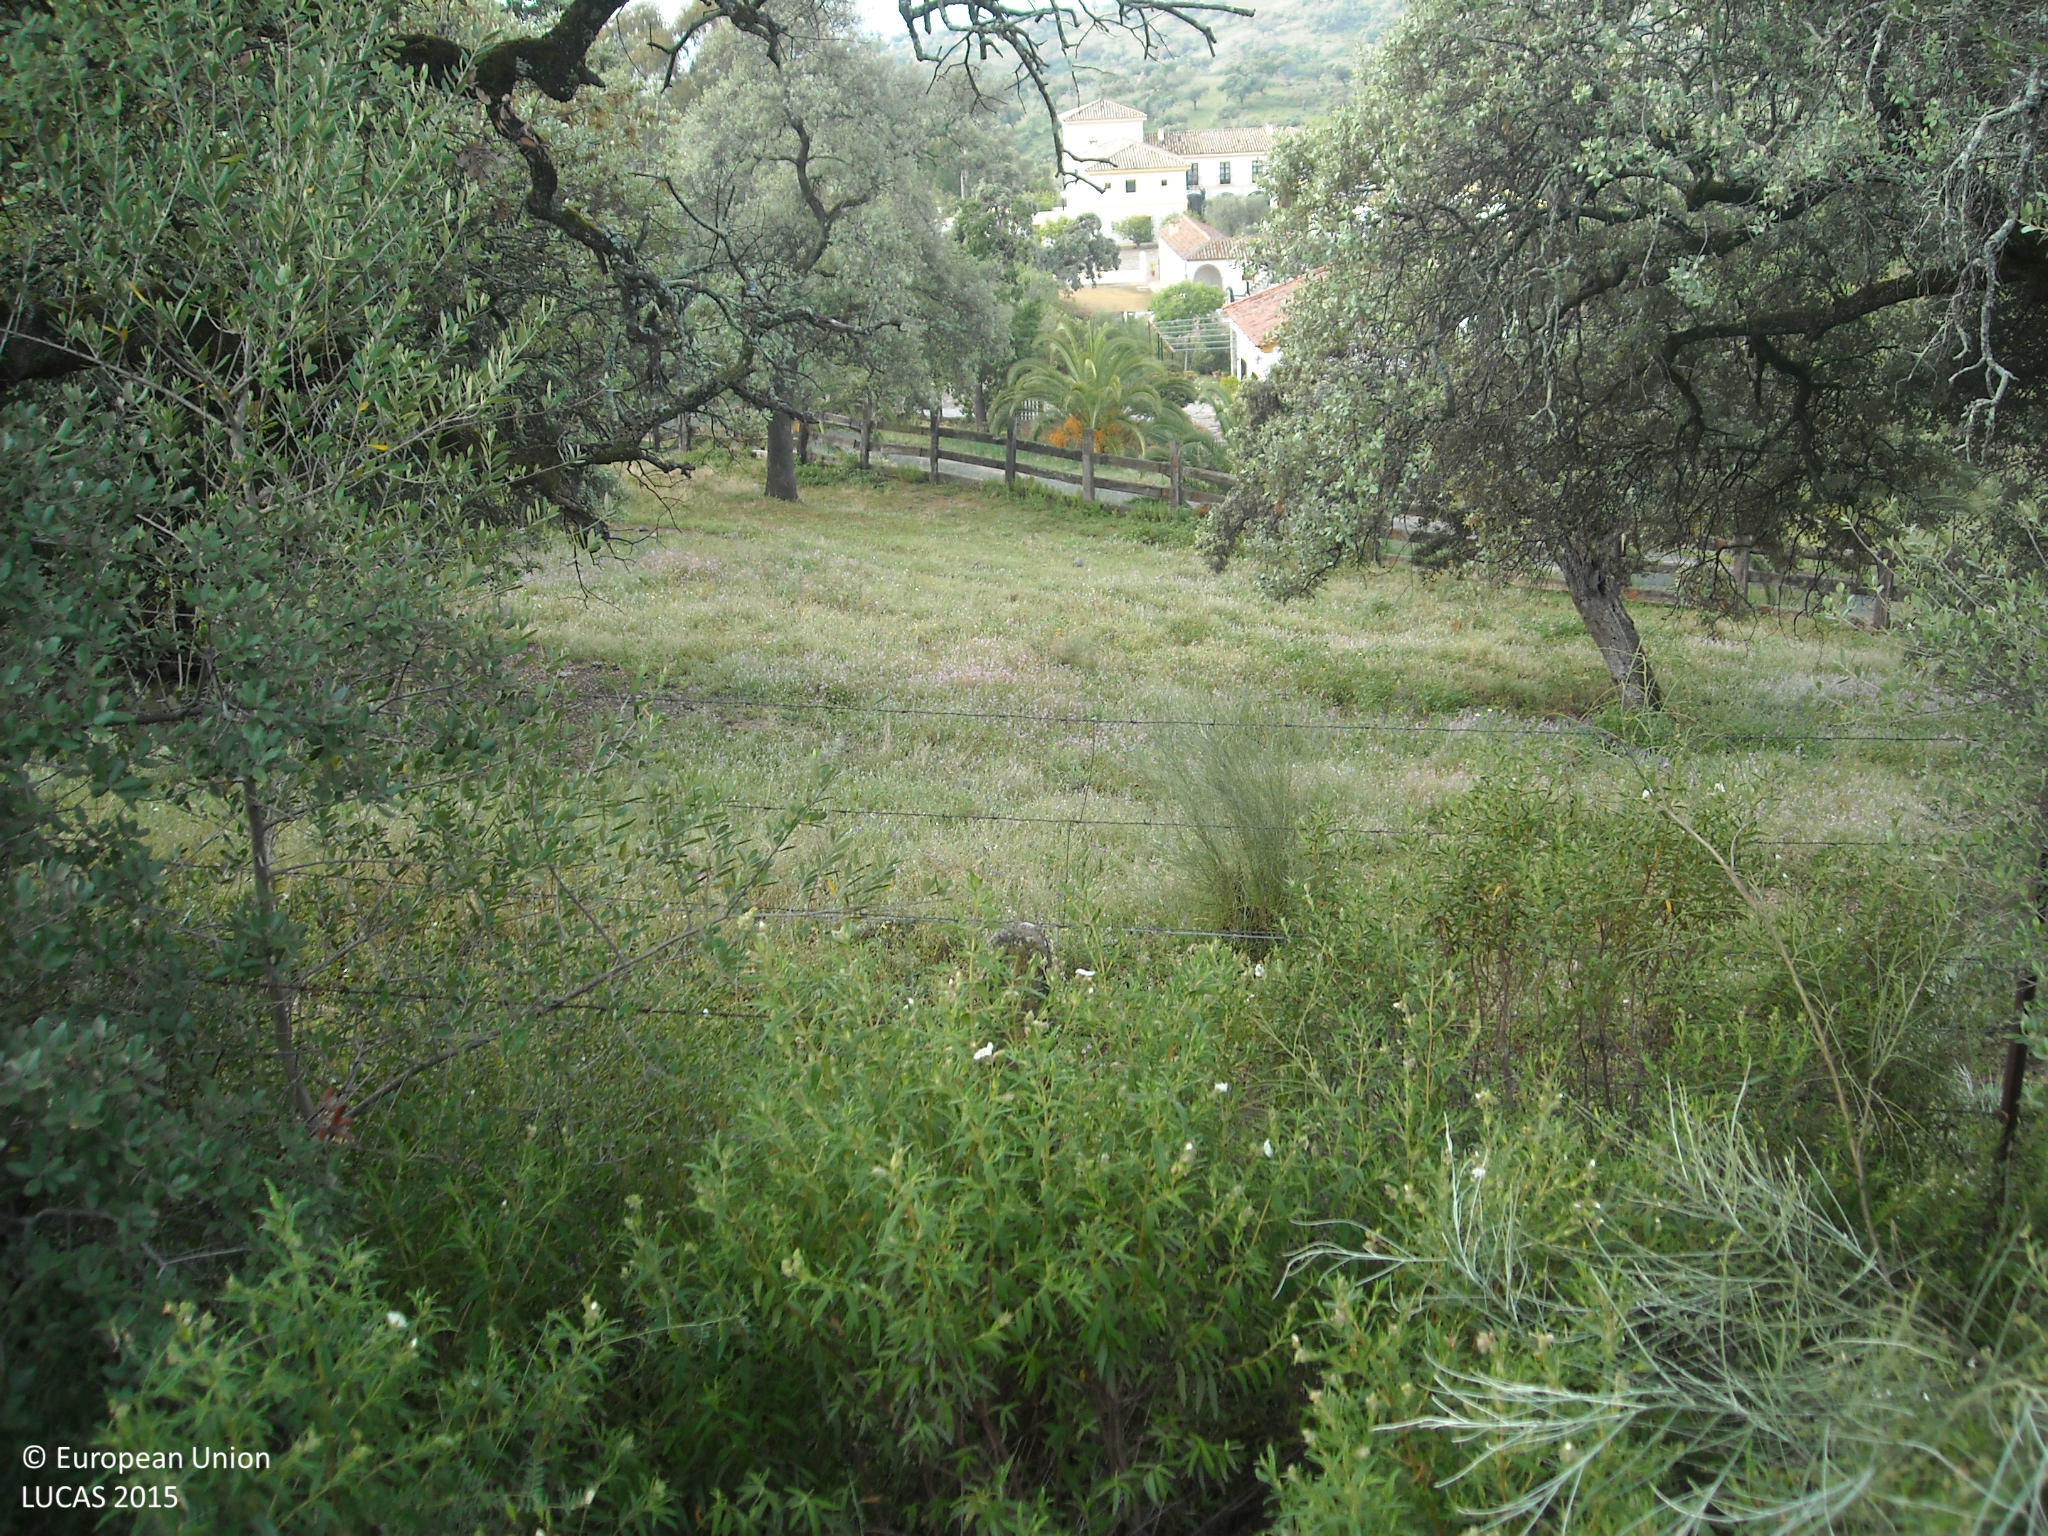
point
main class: Woodland
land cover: Broadleaved woodland
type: broadleaved evergreen forest
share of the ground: 10 - 25 %
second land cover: Grassland without tree/shrub cover
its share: > 75 %
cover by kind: herbaceous plants 70 %, broadleaved forest trees 20 %, shrubs 10 %
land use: Forestry
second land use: Agriculture (excluding fallow land and kitchen gardens)
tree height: > 5 m
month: April
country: ES
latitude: 37.7059
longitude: -6.2428
